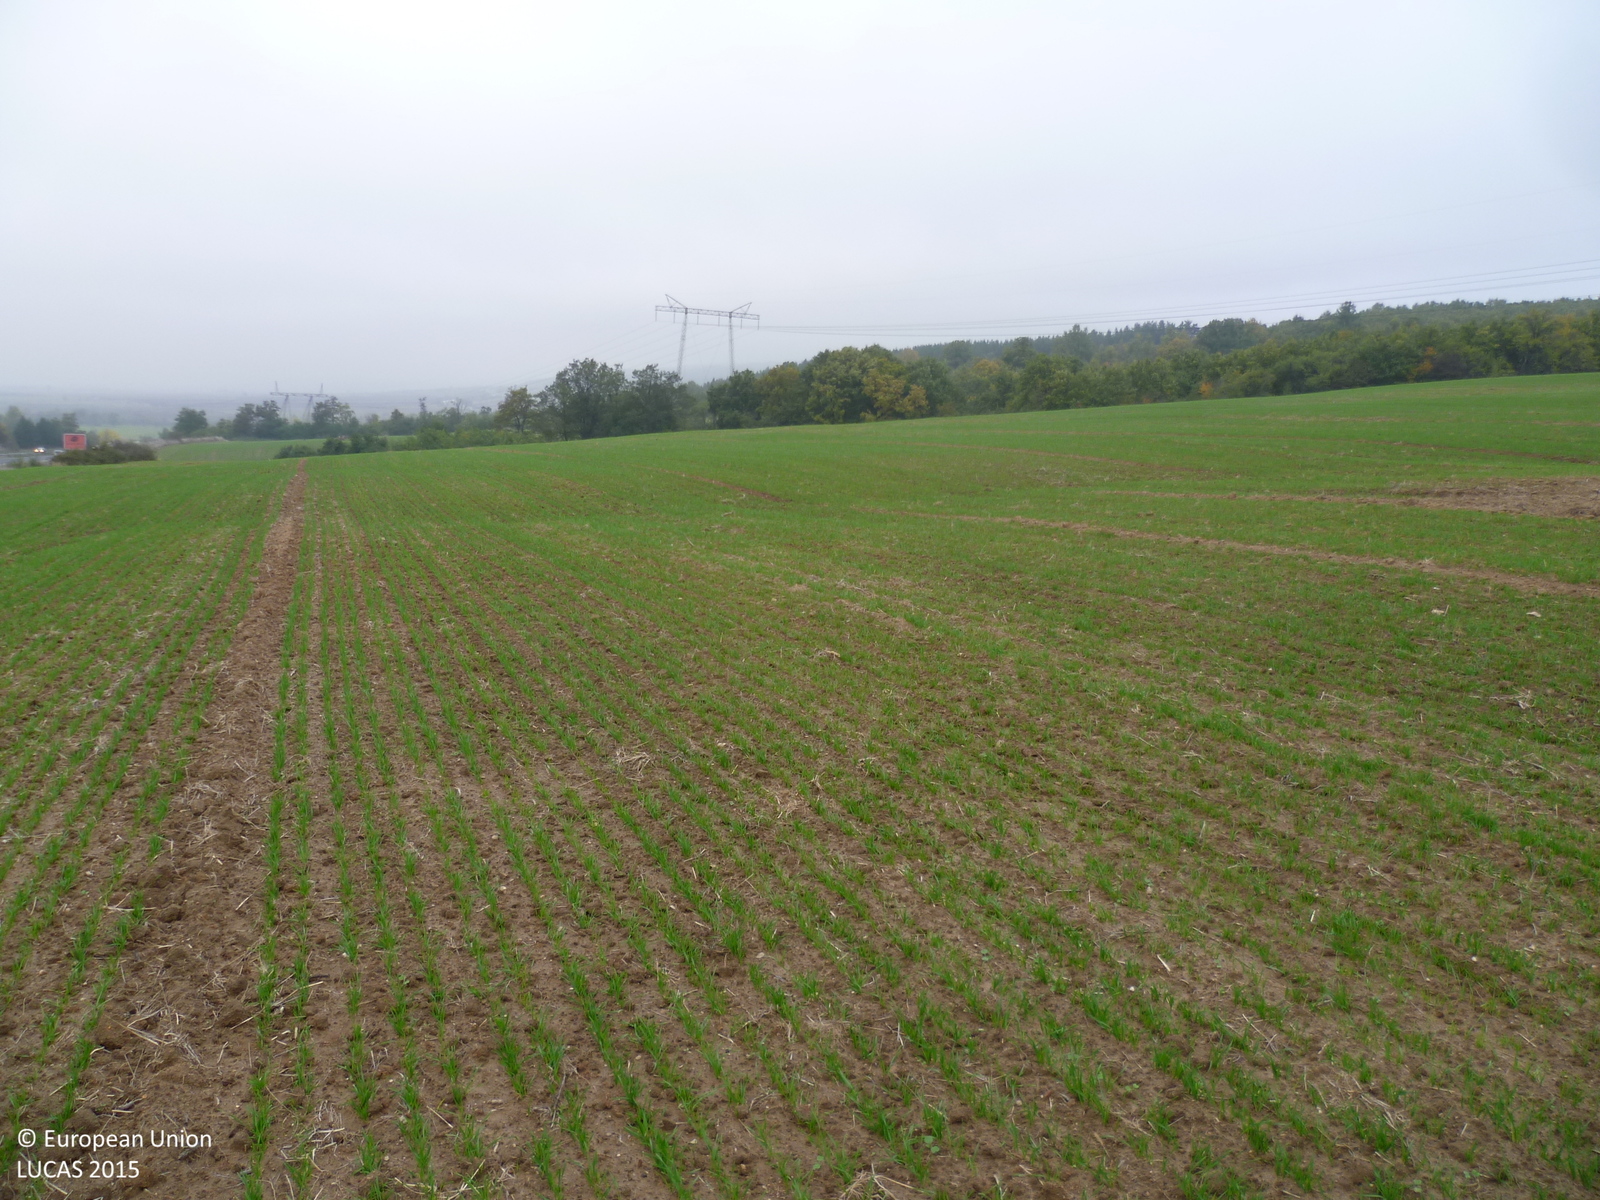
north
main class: Cropland
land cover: Durum wheat
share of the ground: 25 - 50 %
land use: Agriculture (excluding fallow land and kitchen gardens)
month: October
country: BG
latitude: 42.3891
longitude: 23.8750
